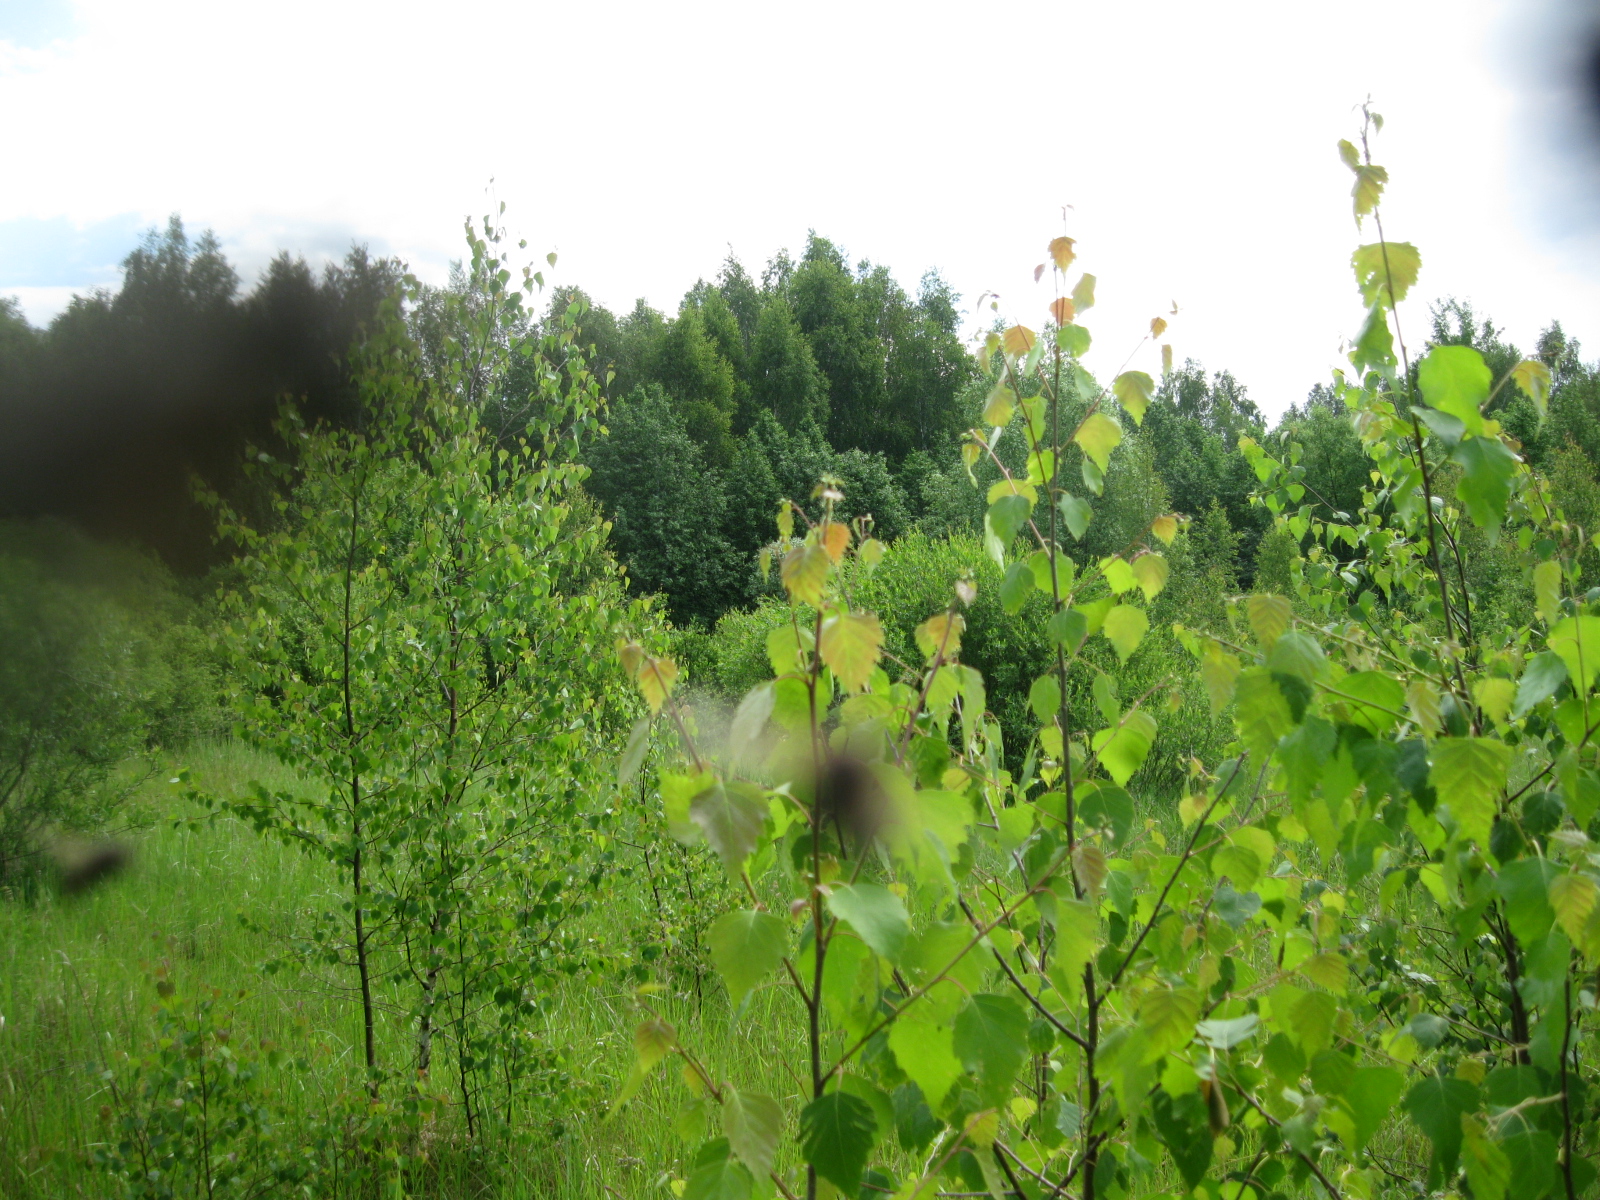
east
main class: Woodland
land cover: Broadleaved woodland
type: non-riverine alder, birch or aspen forest
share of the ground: 50 - 75 %
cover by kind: broadleaved forest trees 60 %, herbaceous plants 30 %, shrubs 10 %
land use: Semi-natural and natural areas not in use
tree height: < 5 m
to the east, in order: Broadleaved woodland; Inland fresh water bodies; Broadleaved woodland; Ditches and canals; Broadleaved woodland; Grassland with sparse tree/shrub cover
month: June
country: LT
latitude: 55.5936
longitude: 24.0379
